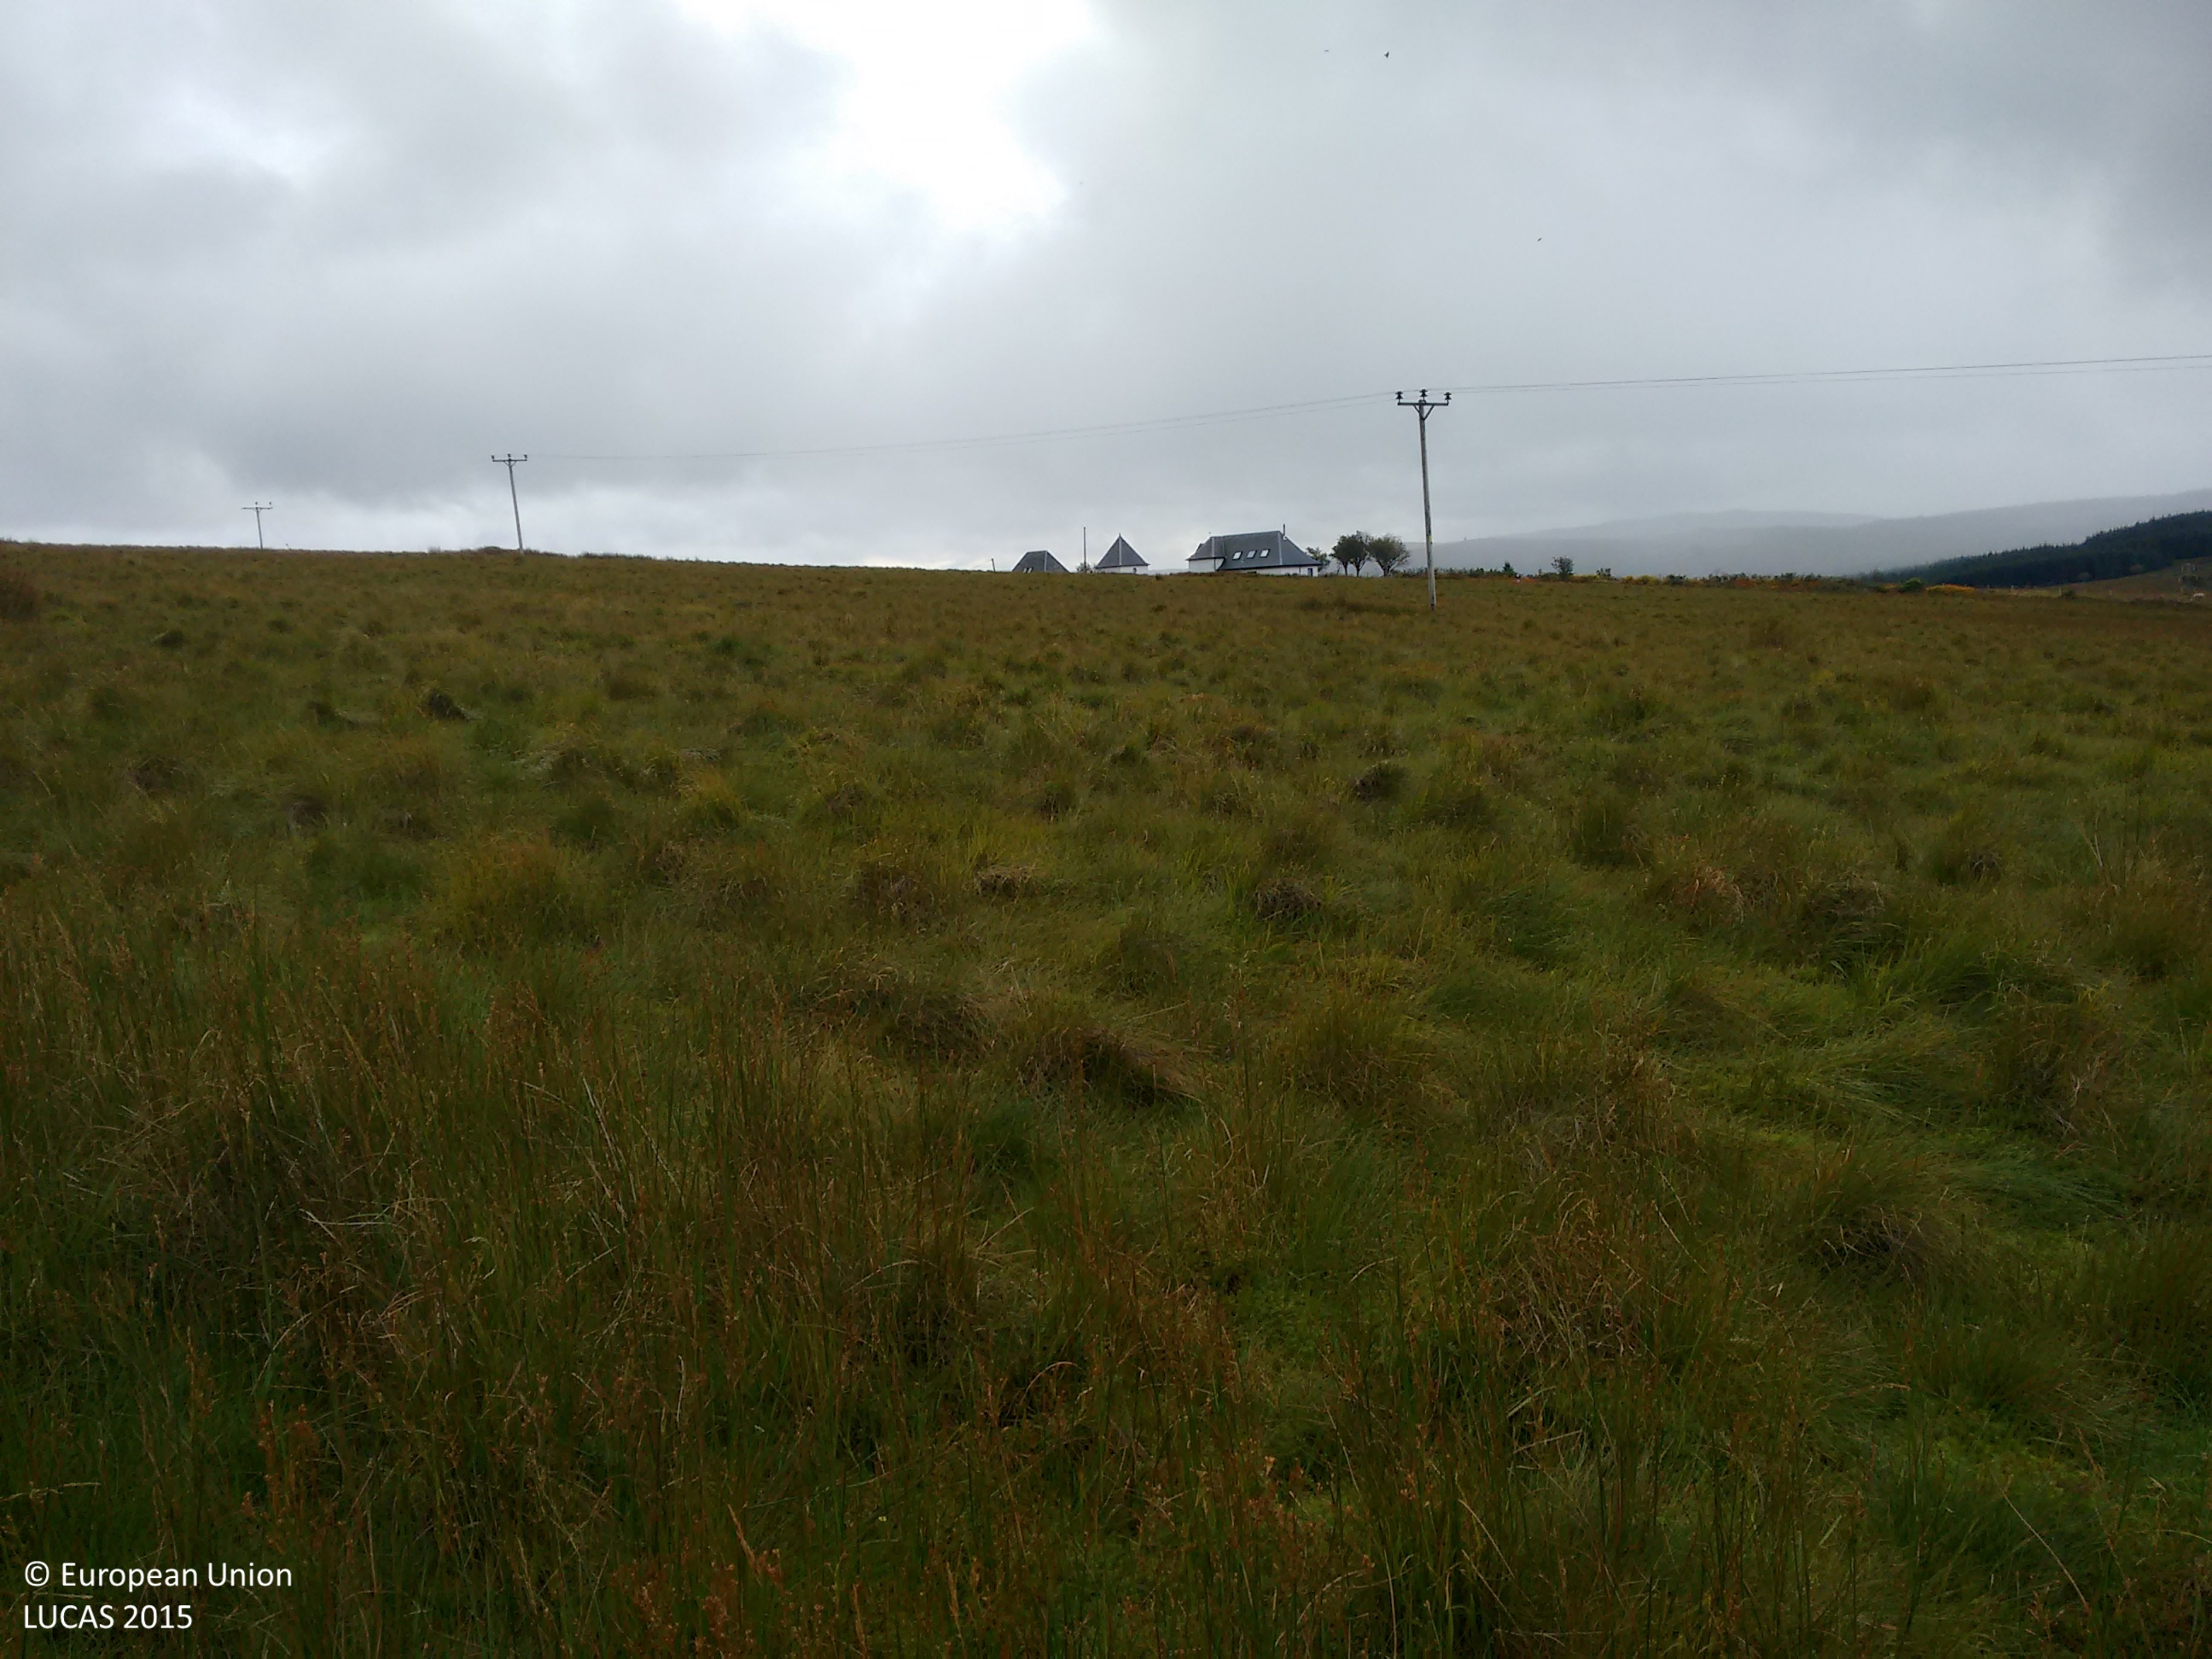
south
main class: Grassland
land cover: Grassland without tree/shrub cover
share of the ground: > 75 %
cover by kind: herbaceous plants 90 %, lichens and mosses 10 %
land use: Agriculture (excluding fallow land and kitchen gardens)
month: September
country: GB
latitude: 55.7941
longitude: -5.4498
